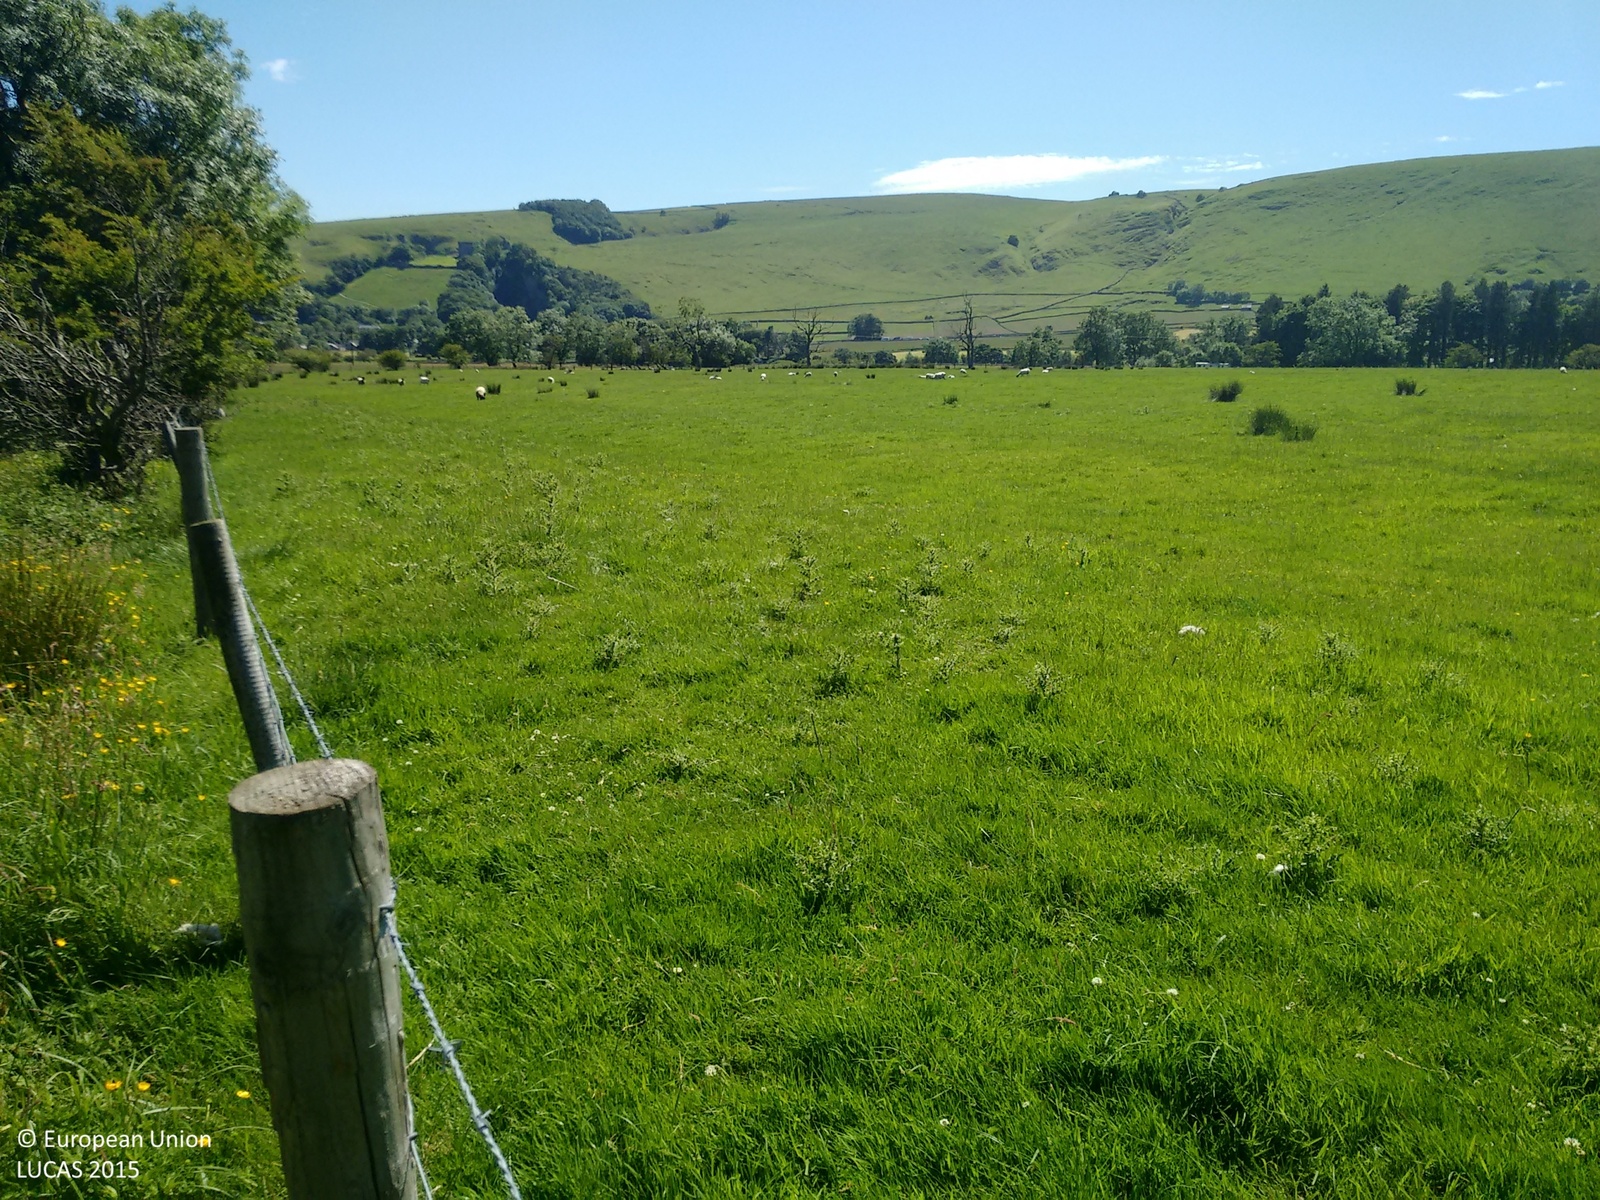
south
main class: Grassland
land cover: Grassland without tree/shrub cover
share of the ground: > 75 %
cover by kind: herbaceous plants 100 %
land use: Agriculture (excluding fallow land and kitchen gardens)
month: June
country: GB
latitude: 53.3510
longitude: -1.7872
